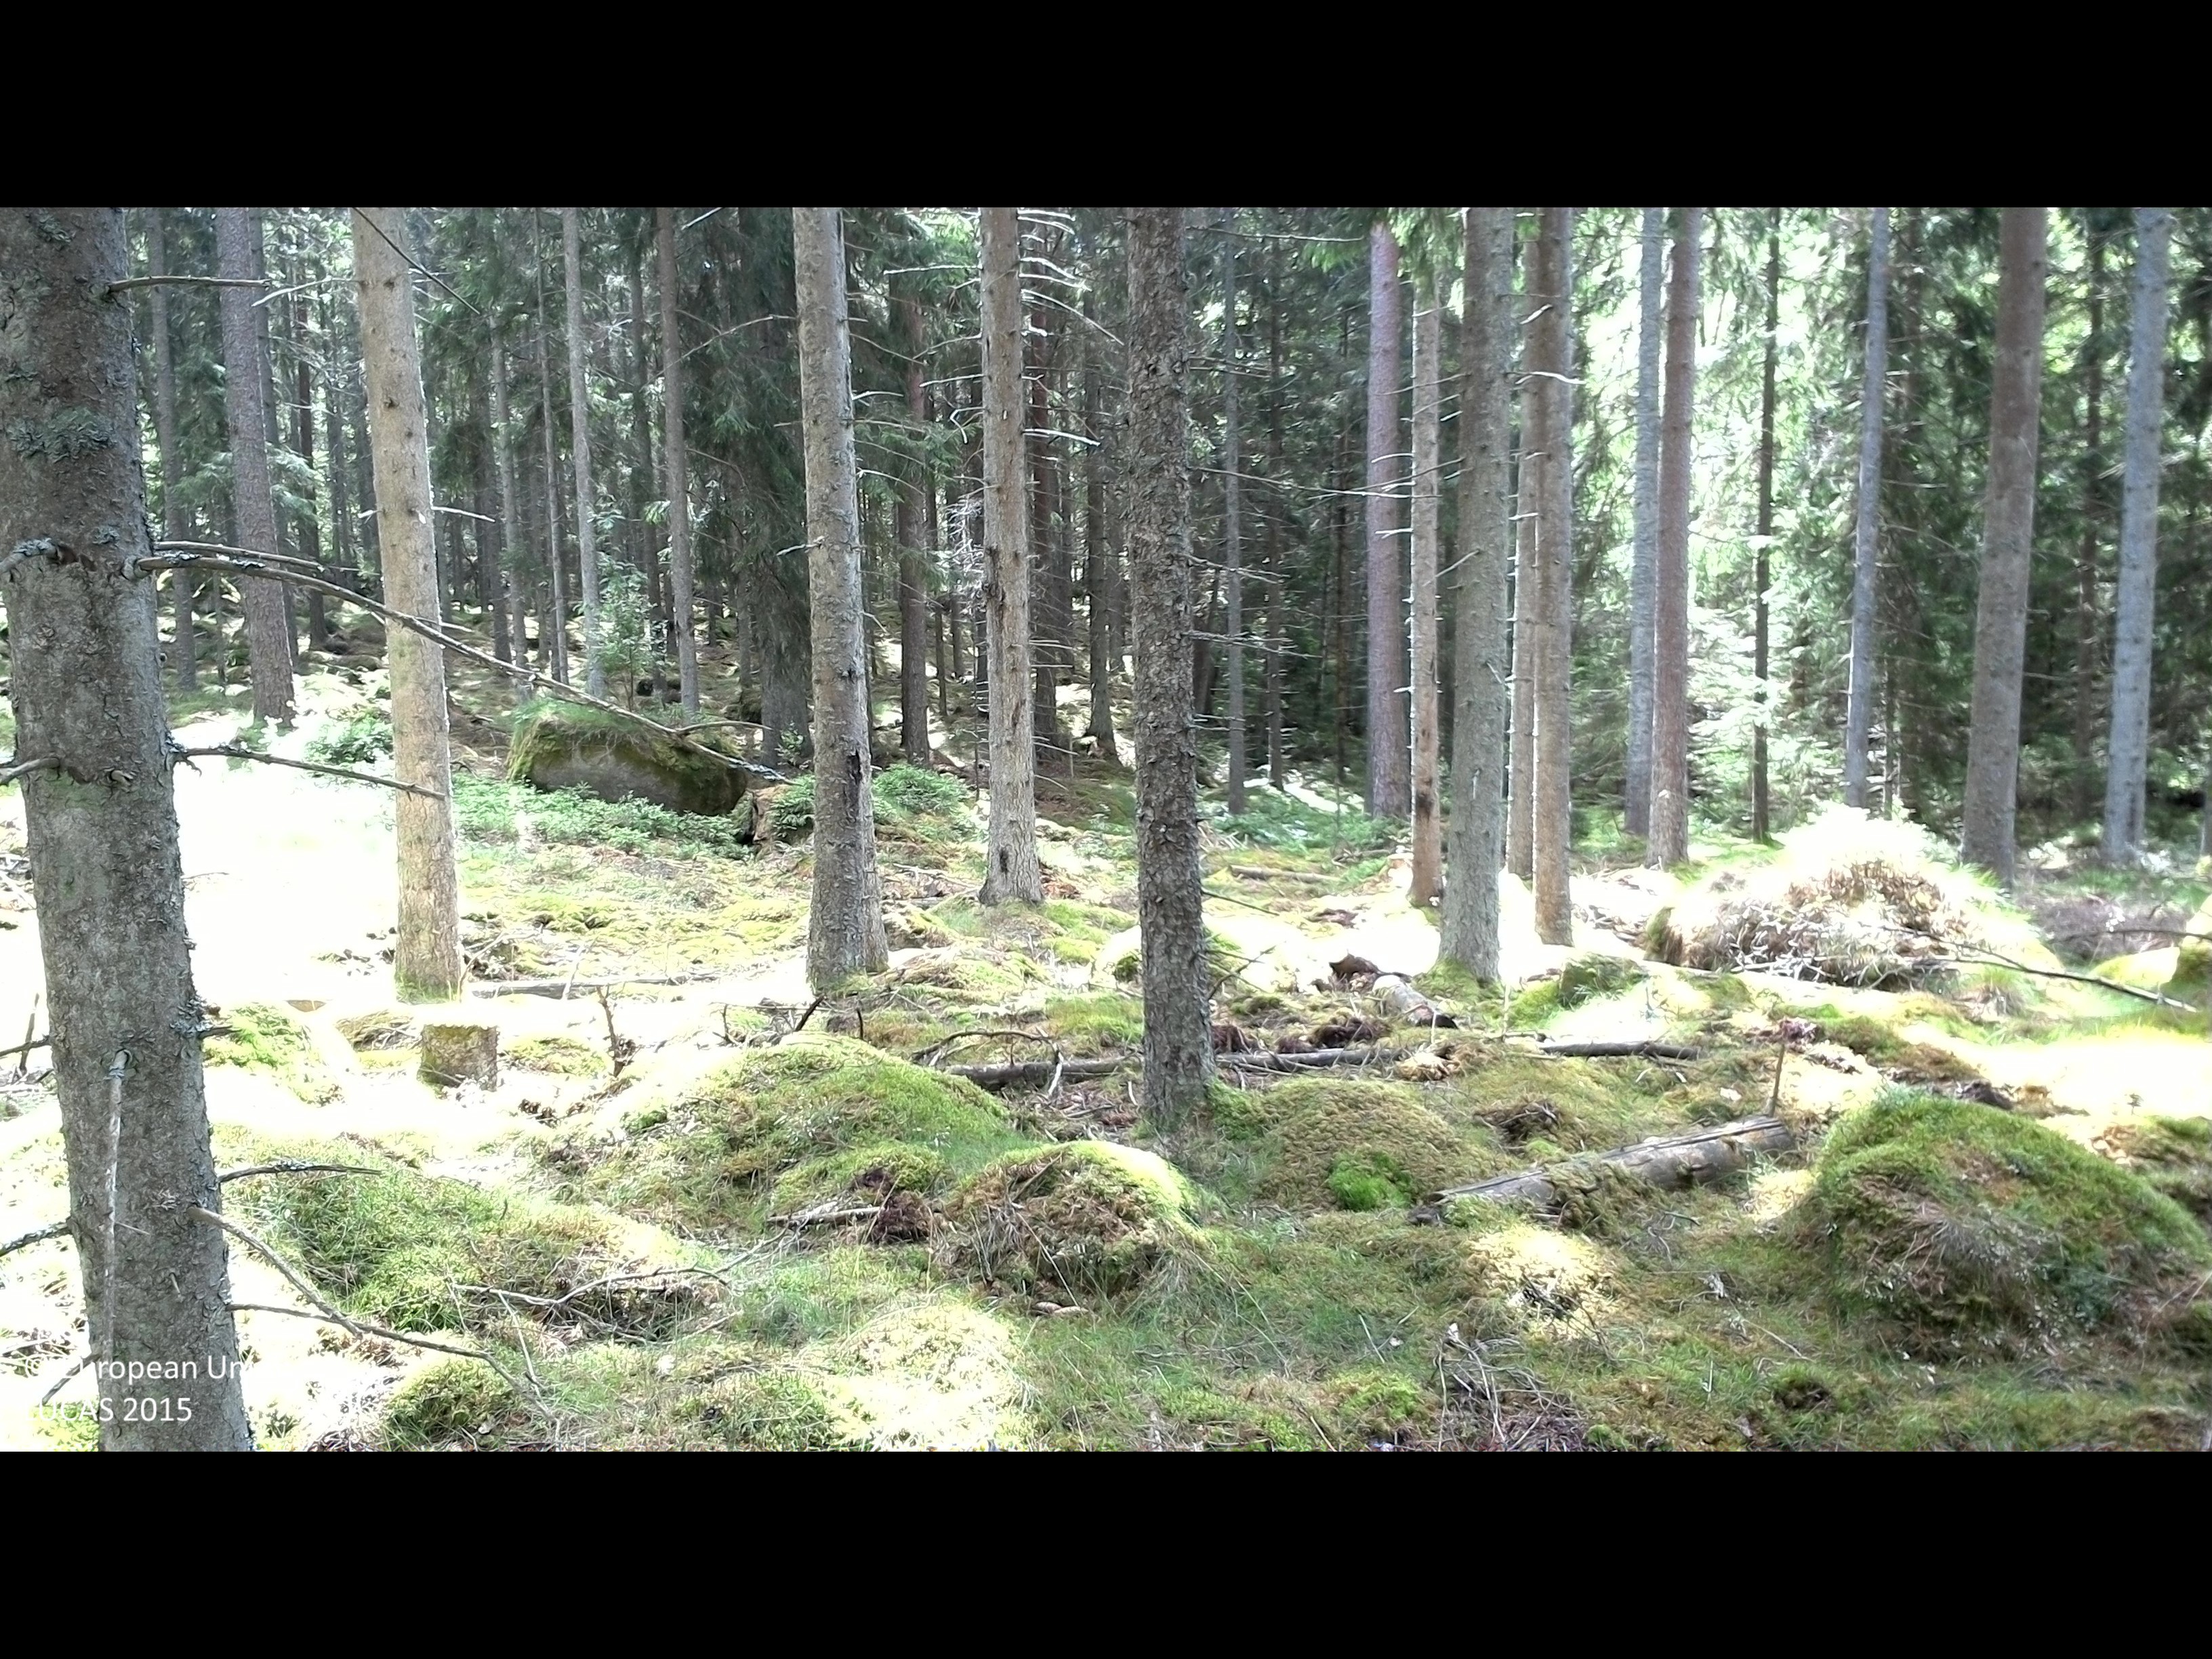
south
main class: Woodland
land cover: Spruce dominated coniferous woodland
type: boreal forest
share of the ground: 50 - 75 %
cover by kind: coniferous forest trees 75 %, lichens and mosses 20 %, herbaceous plants 5 %
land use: Forestry
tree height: > 5 m
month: July
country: SE
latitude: 56.3901
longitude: 15.1659
